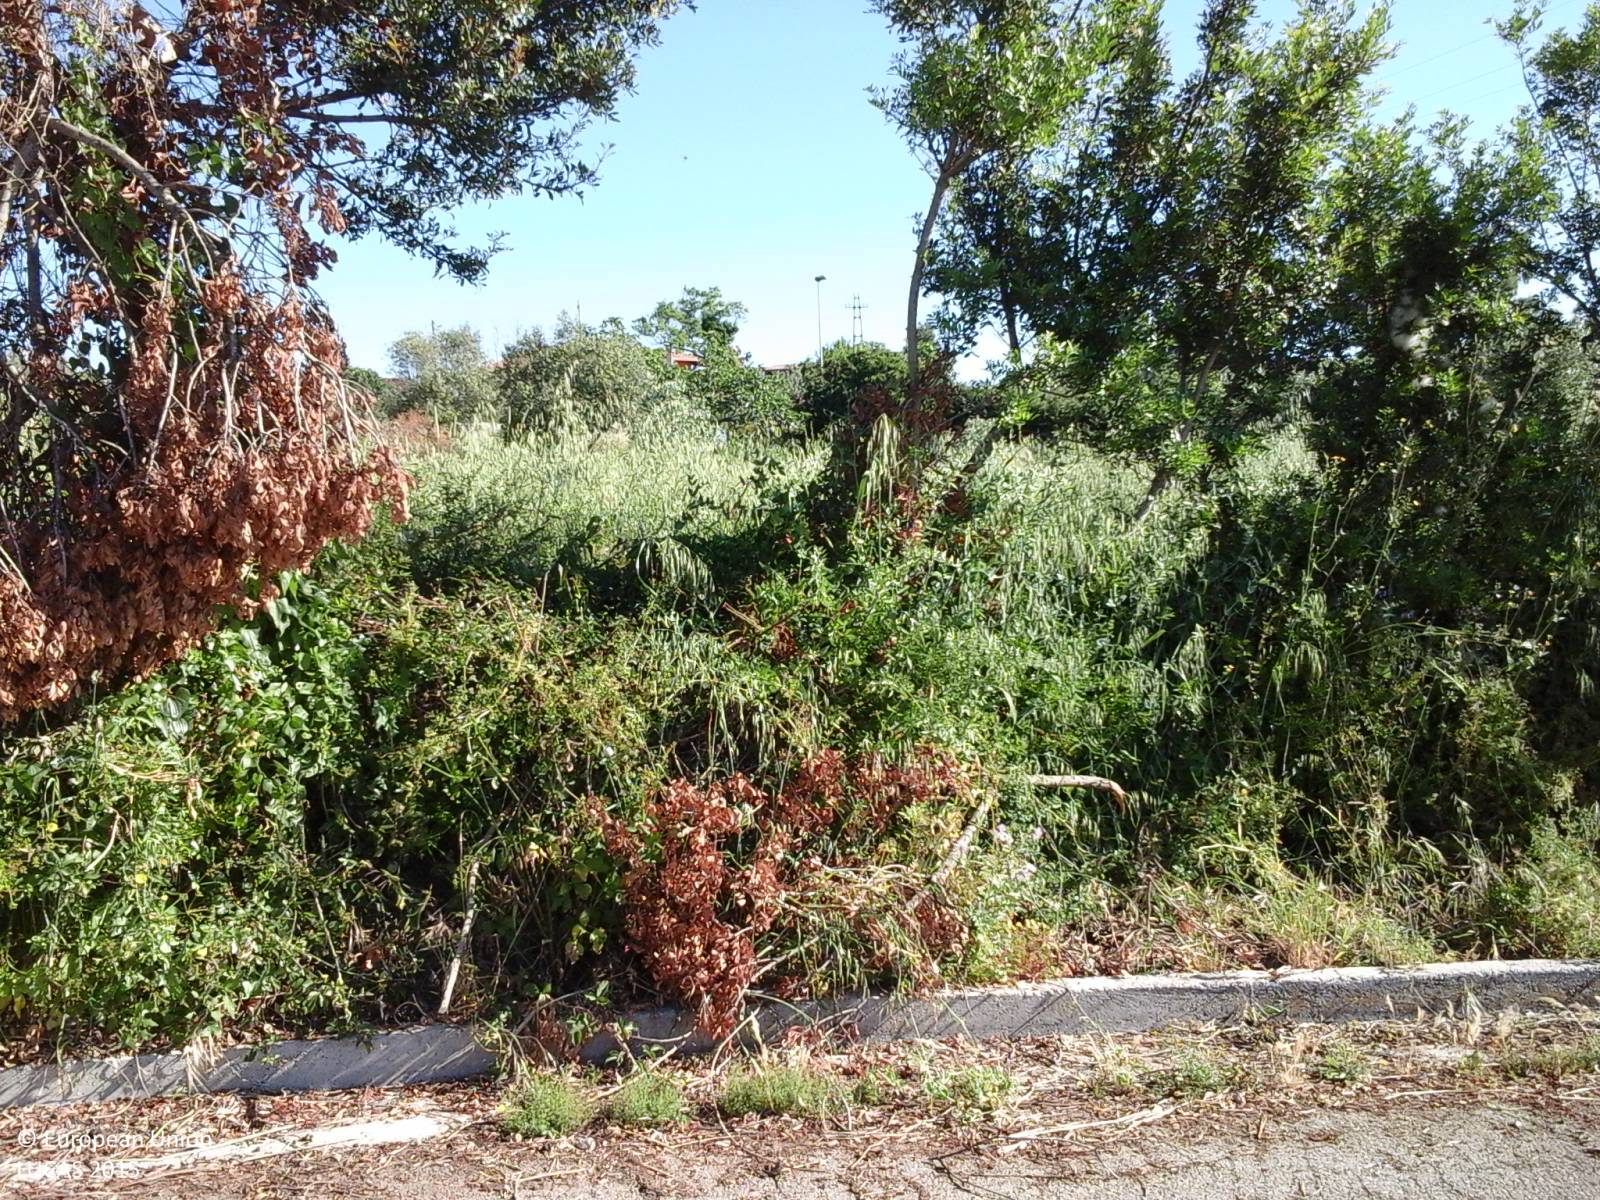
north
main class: Cropland
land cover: Temporary grasslands
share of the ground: > 75 %
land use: Agriculture (excluding fallow land and kitchen gardens)
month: May
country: IT
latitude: 39.7892
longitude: 8.8040
